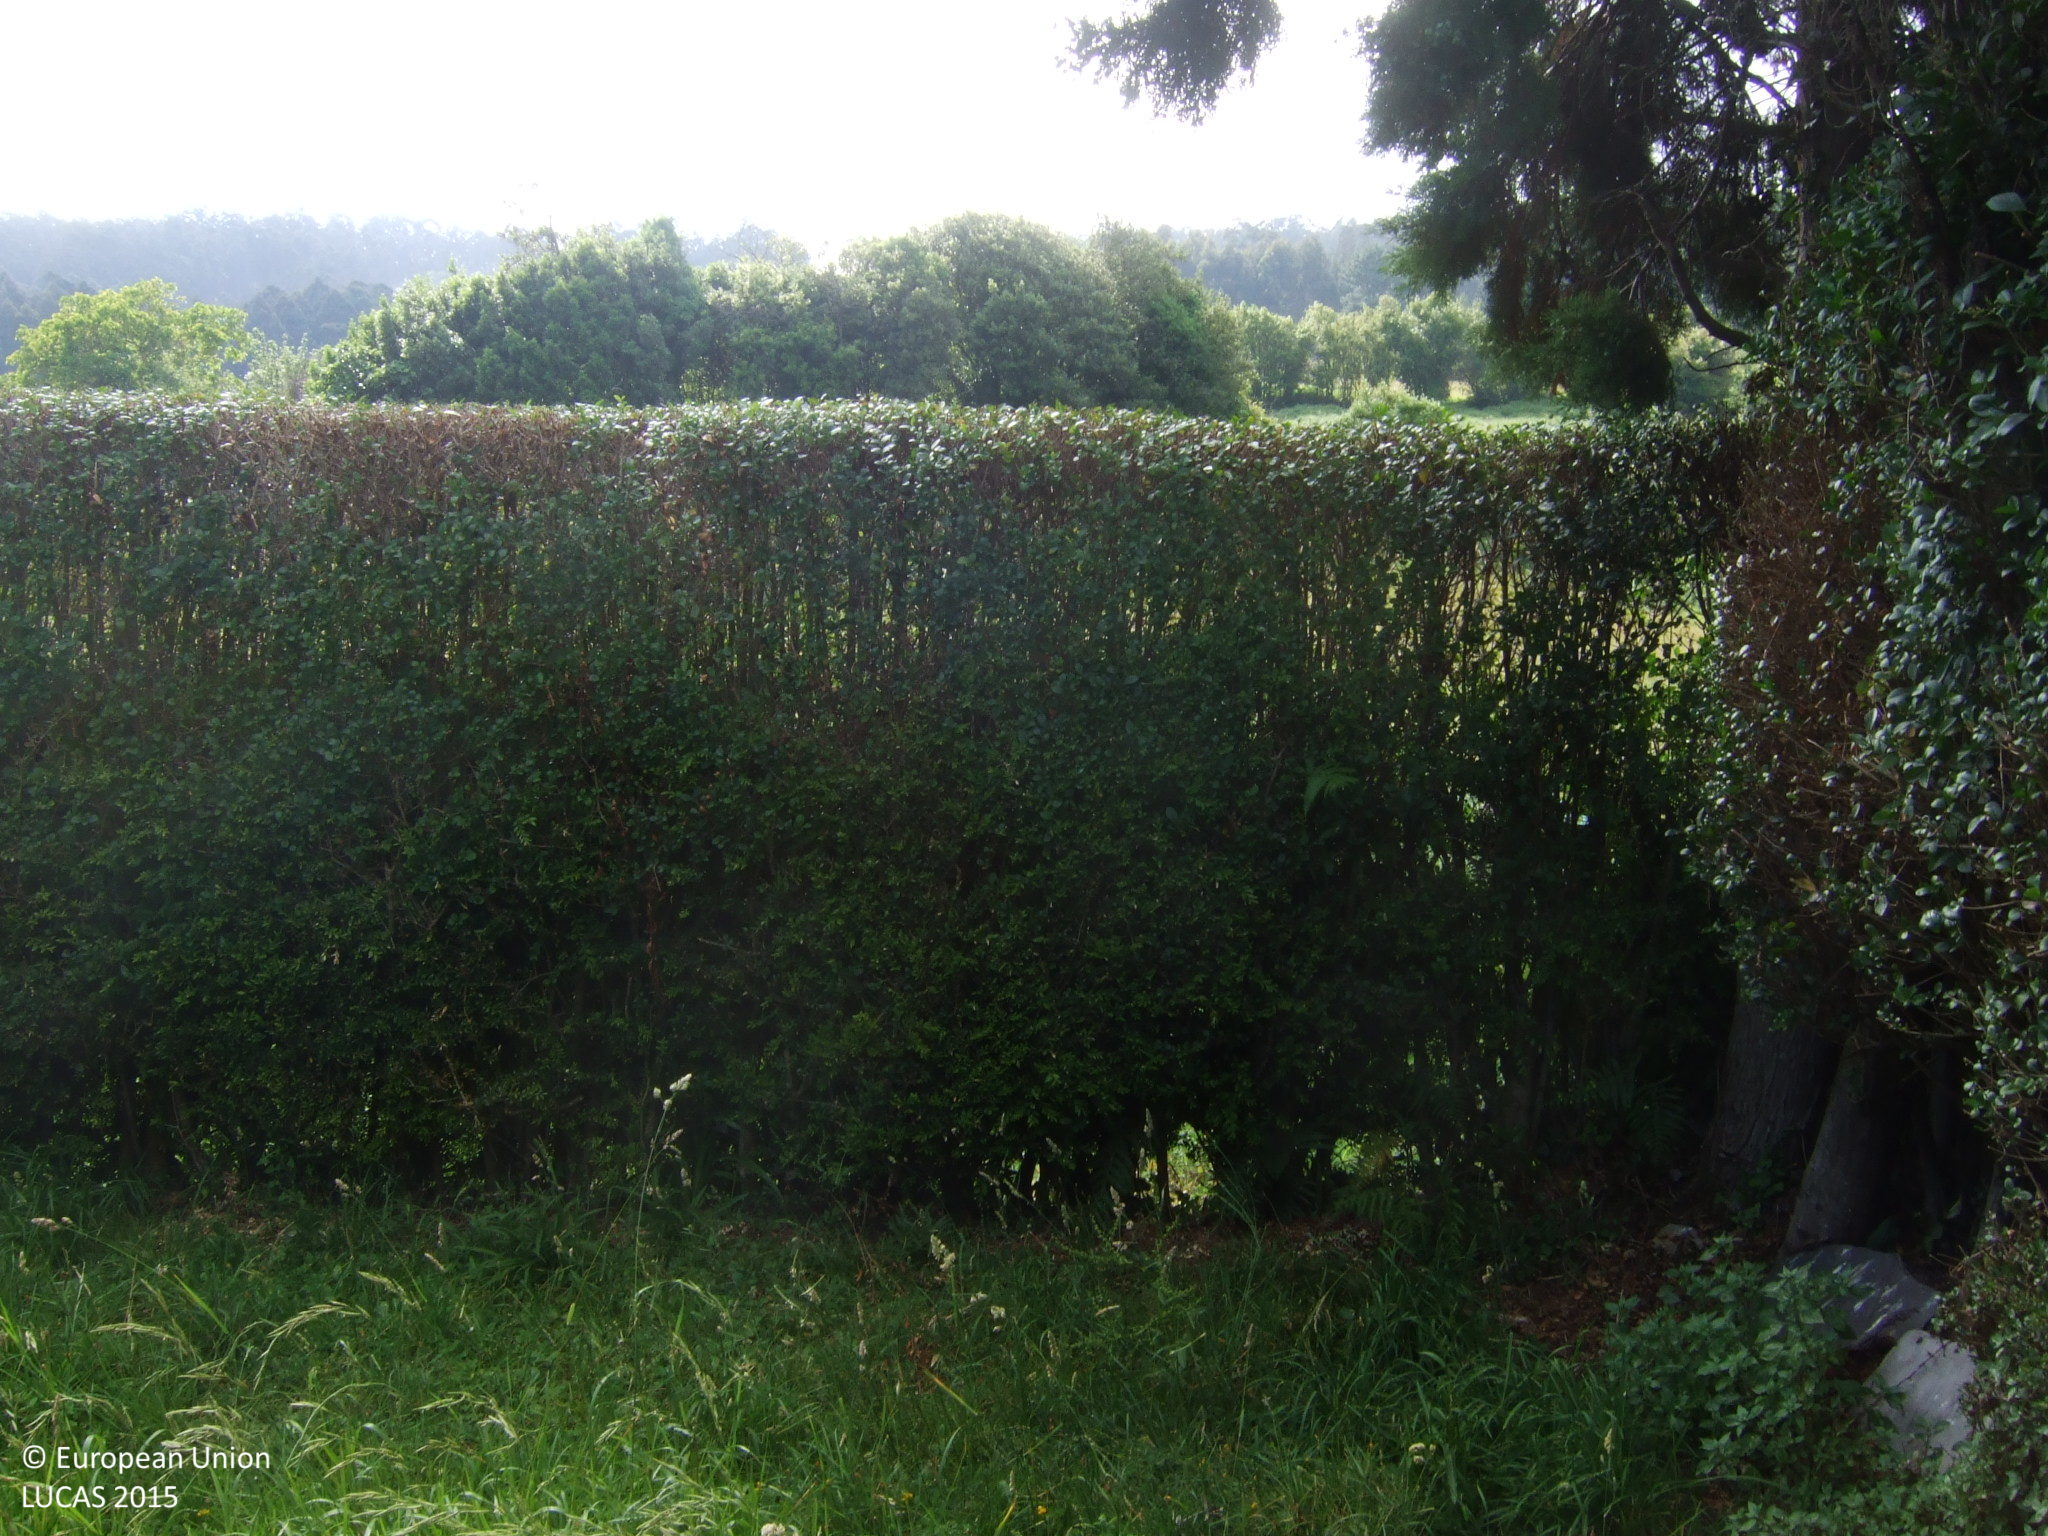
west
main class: Grassland
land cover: Grassland without tree/shrub cover
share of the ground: > 75 %
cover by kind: herbaceous plants 100 %
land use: Agriculture (excluding fallow land and kitchen gardens)
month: June
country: ES
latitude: 43.6945
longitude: -7.6189
